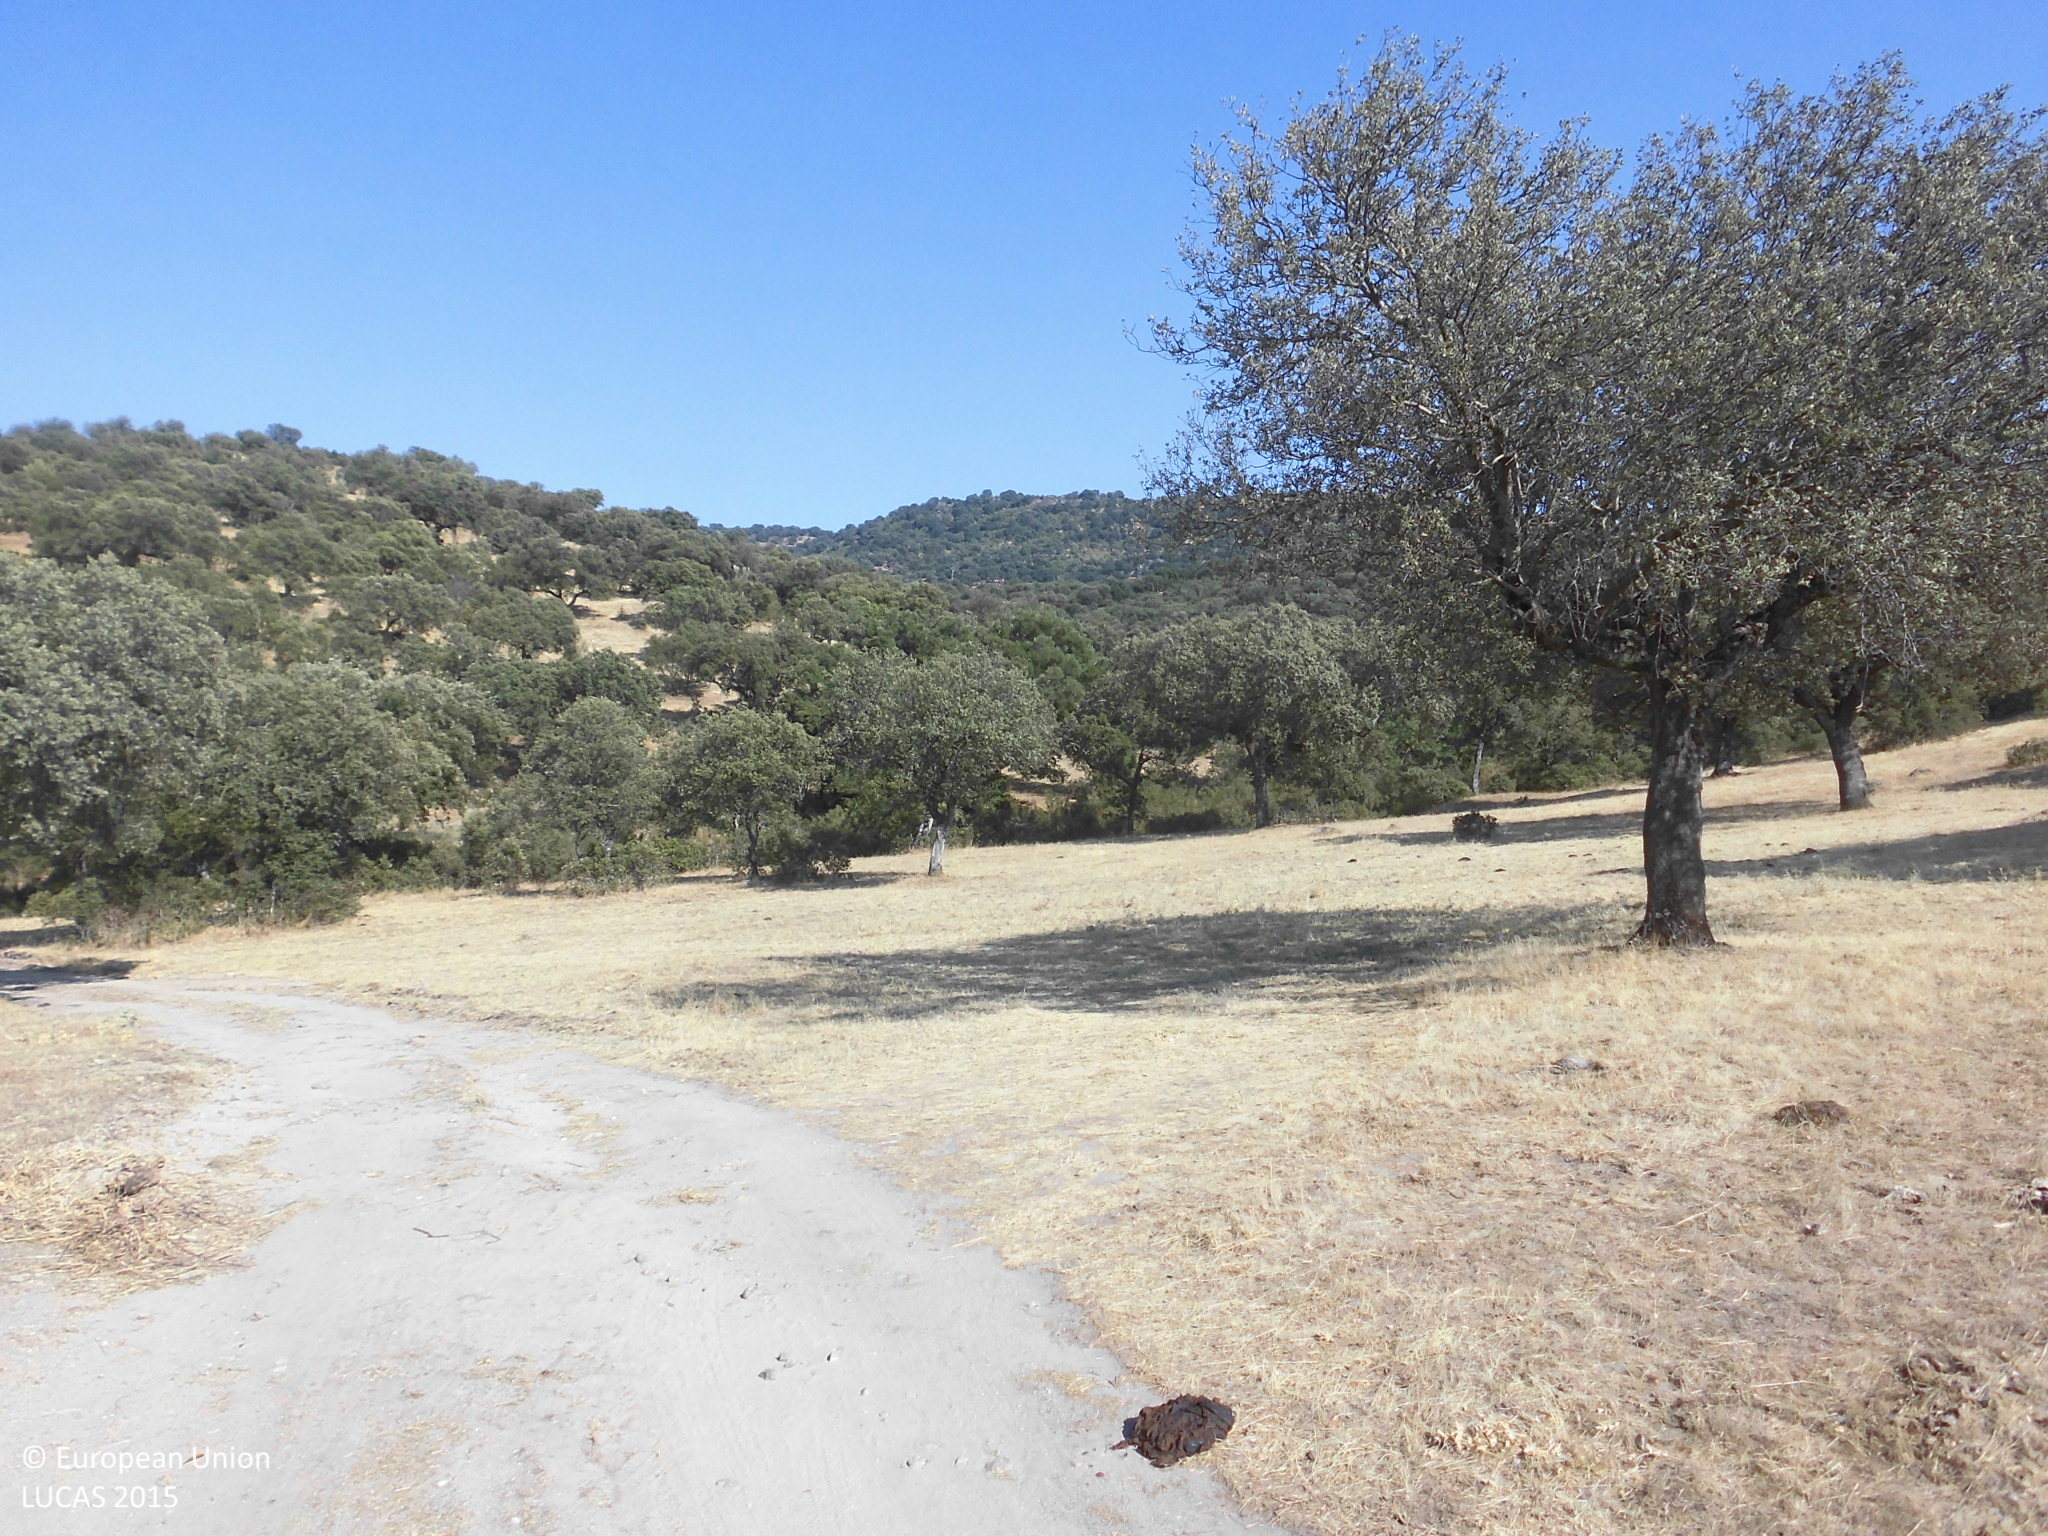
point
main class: Woodland
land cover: Broadleaved woodland
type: broadleaved evergreen forest
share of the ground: 25 - 50 %
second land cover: Grassland without tree/shrub cover
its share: > 75 %
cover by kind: herbaceous plants 55 %, broadleaved forest trees 45 %
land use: Forestry
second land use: Agriculture (excluding fallow land and kitchen gardens)
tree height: > 5 m
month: July
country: ES
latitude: 40.0903
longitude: -6.0820
